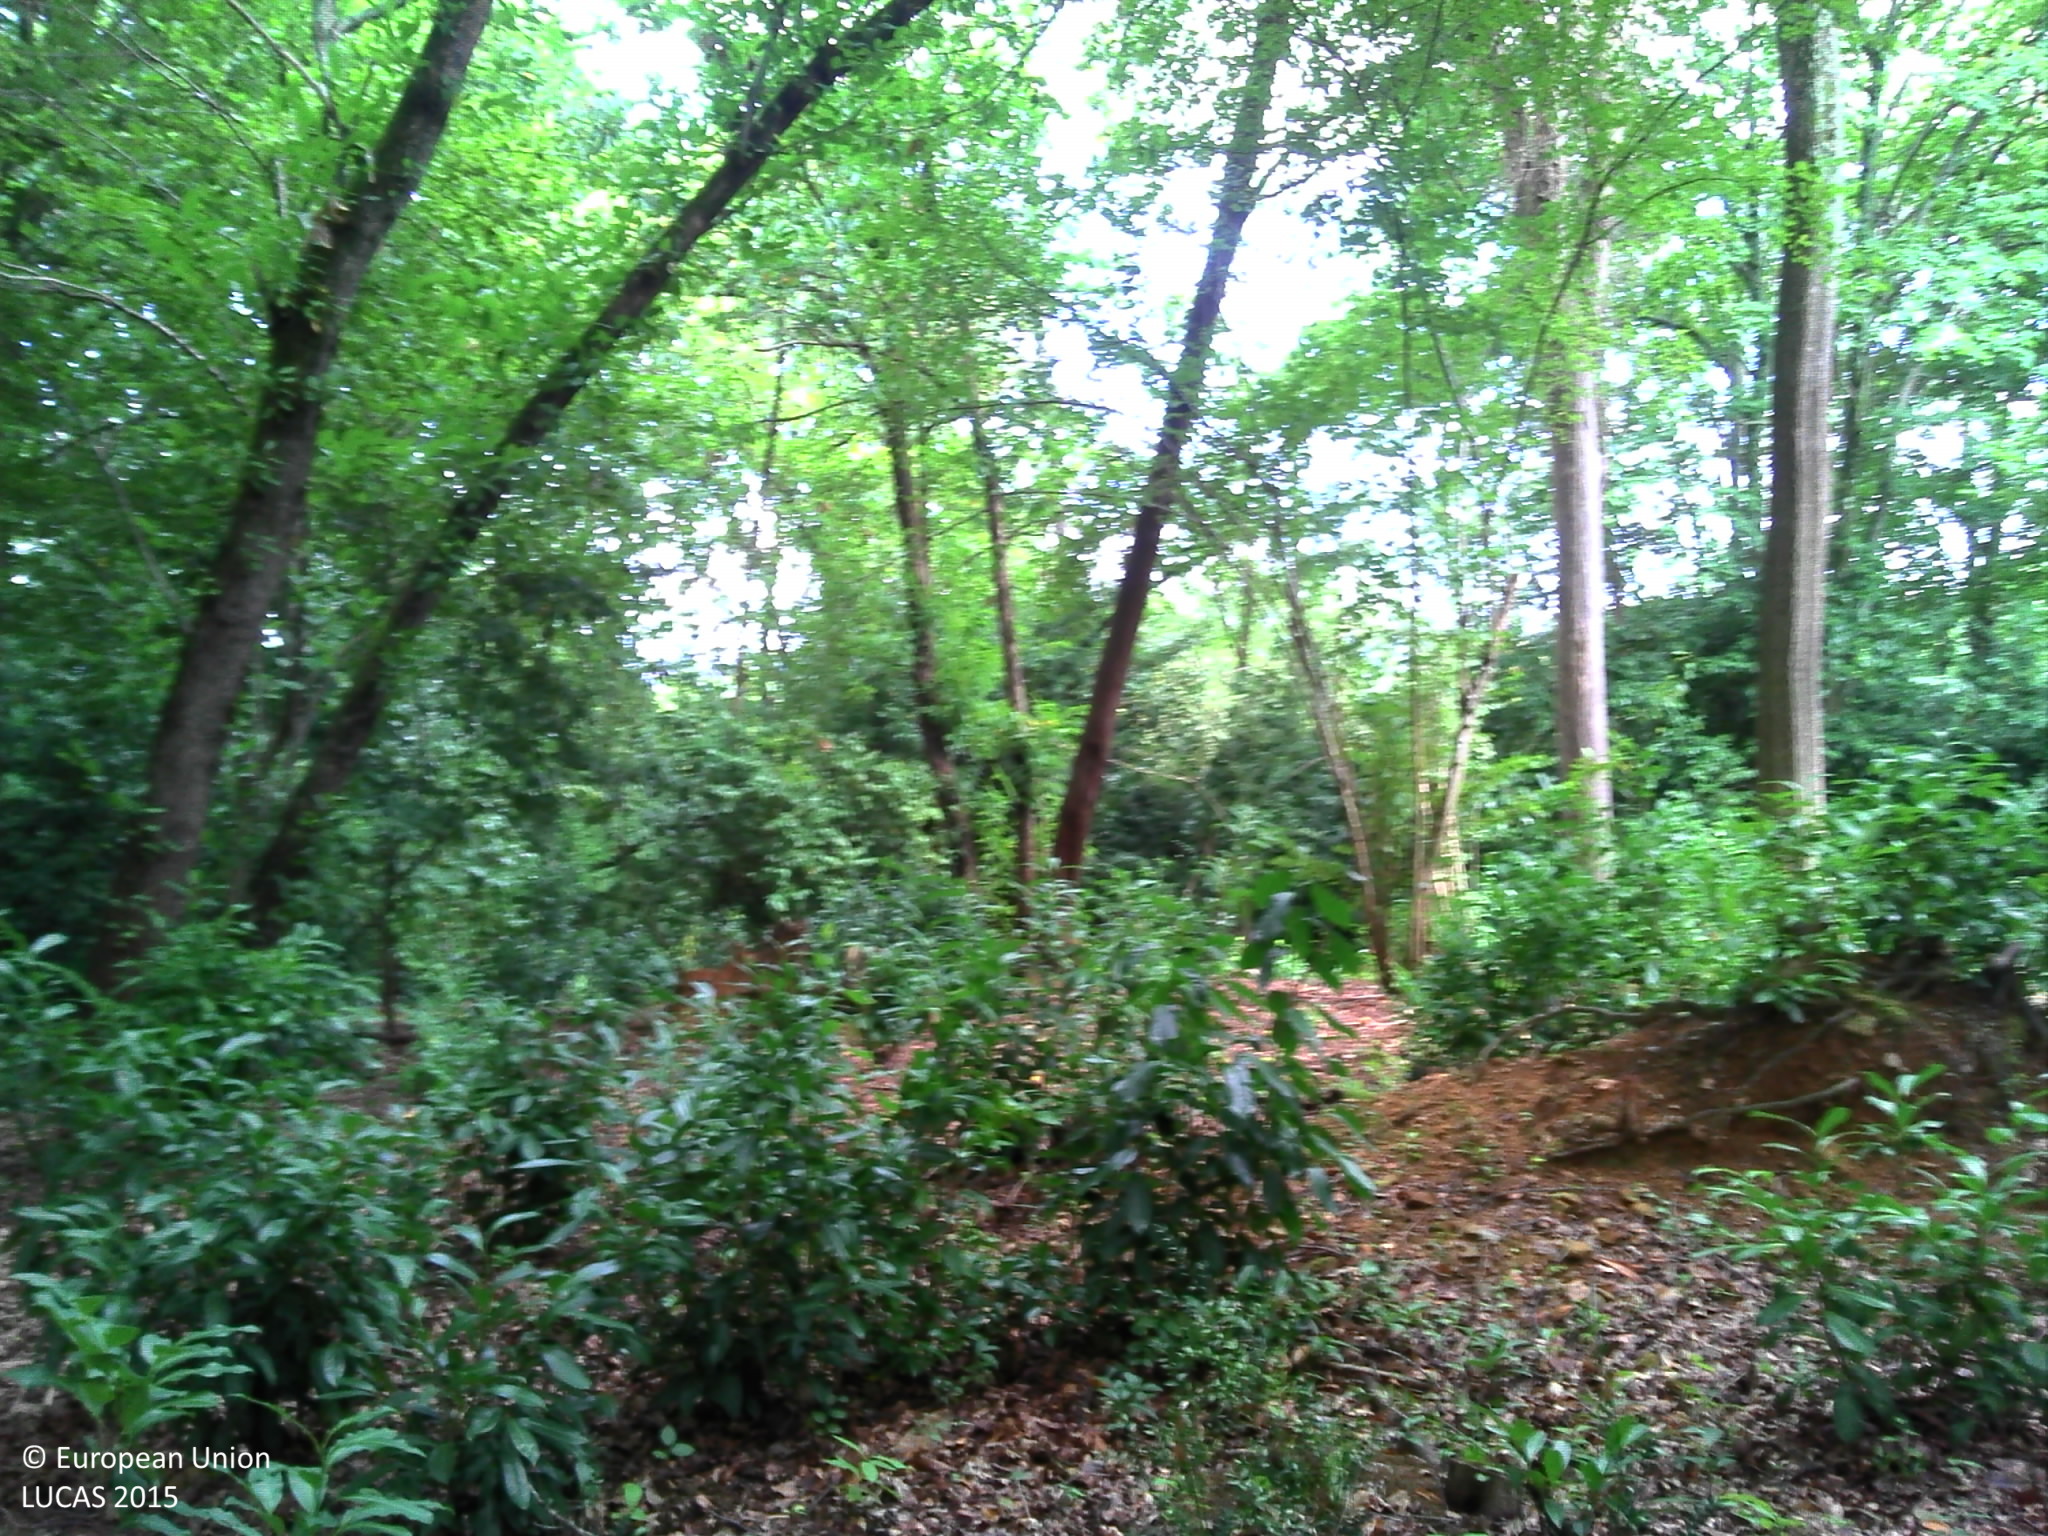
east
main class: Woodland
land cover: Broadleaved woodland
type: acidophilous oak and oak-birch forest
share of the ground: > 75 %
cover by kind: broadleaved forest trees 80 %, shrubs 10 %, herbaceous plants 5 %, lichens and mosses 5 %
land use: Forestry
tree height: > 5 m
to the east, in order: Broadleaved woodland; Tracks; Broadleaved woodland
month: September
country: FR
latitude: 43.2818
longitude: -0.3953
